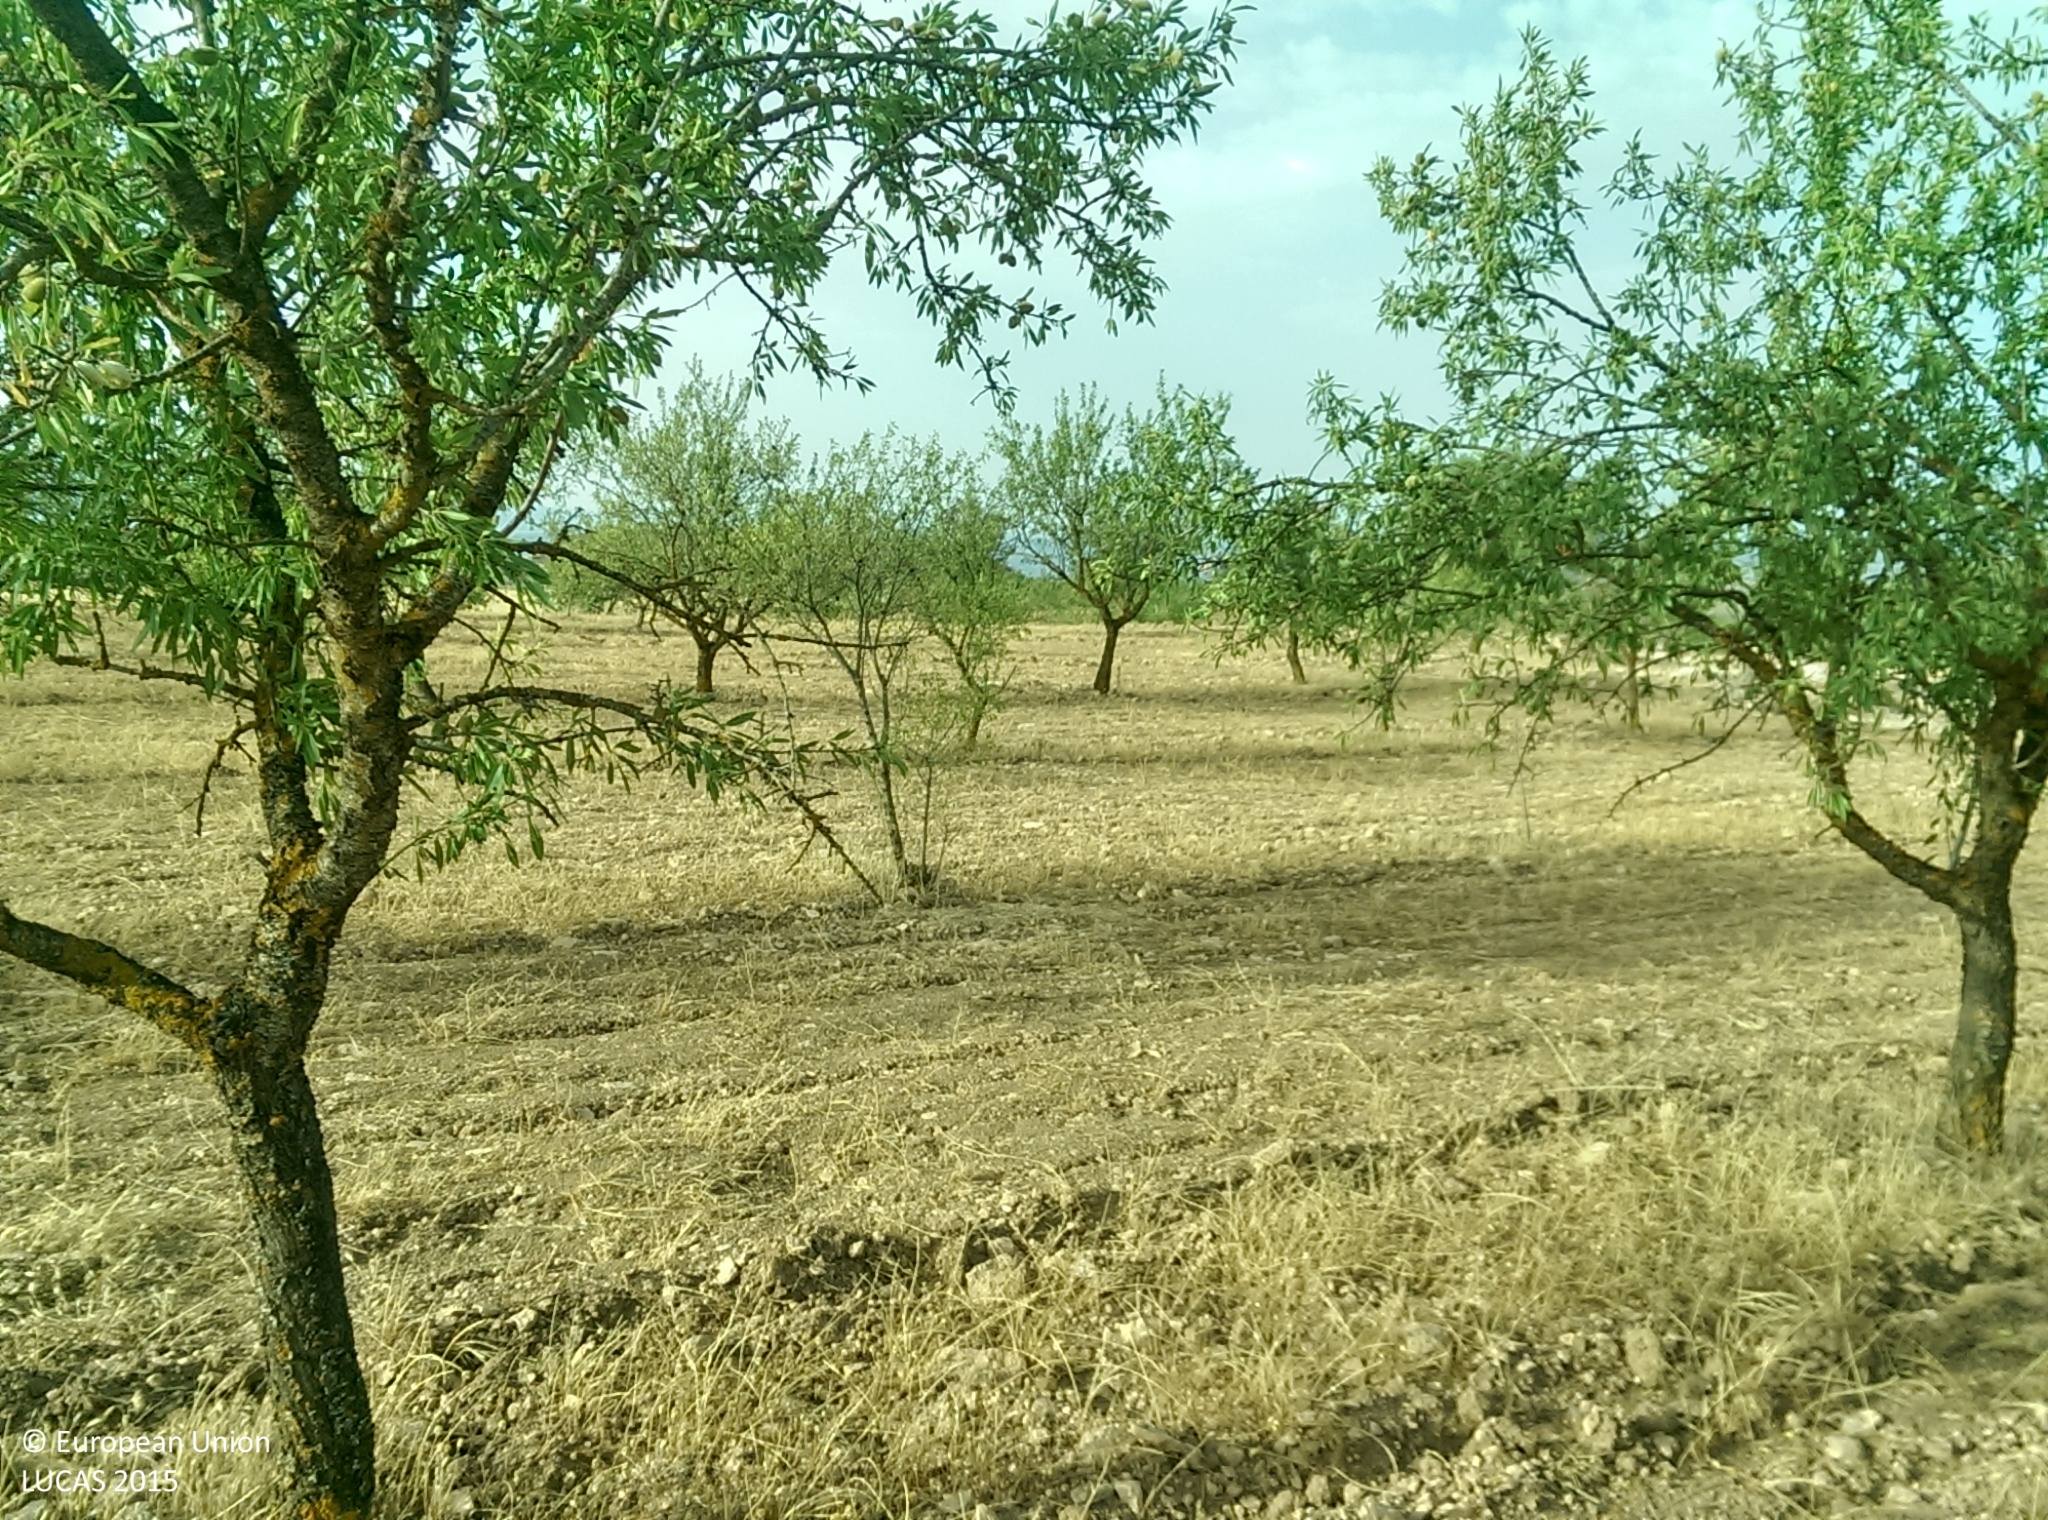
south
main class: Cropland
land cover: Nuts trees
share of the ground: 25 - 50 %
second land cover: Other bare soil
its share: > 75 %
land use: Agriculture (excluding fallow land and kitchen gardens)
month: July
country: ES
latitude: 37.6085
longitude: -2.9608
